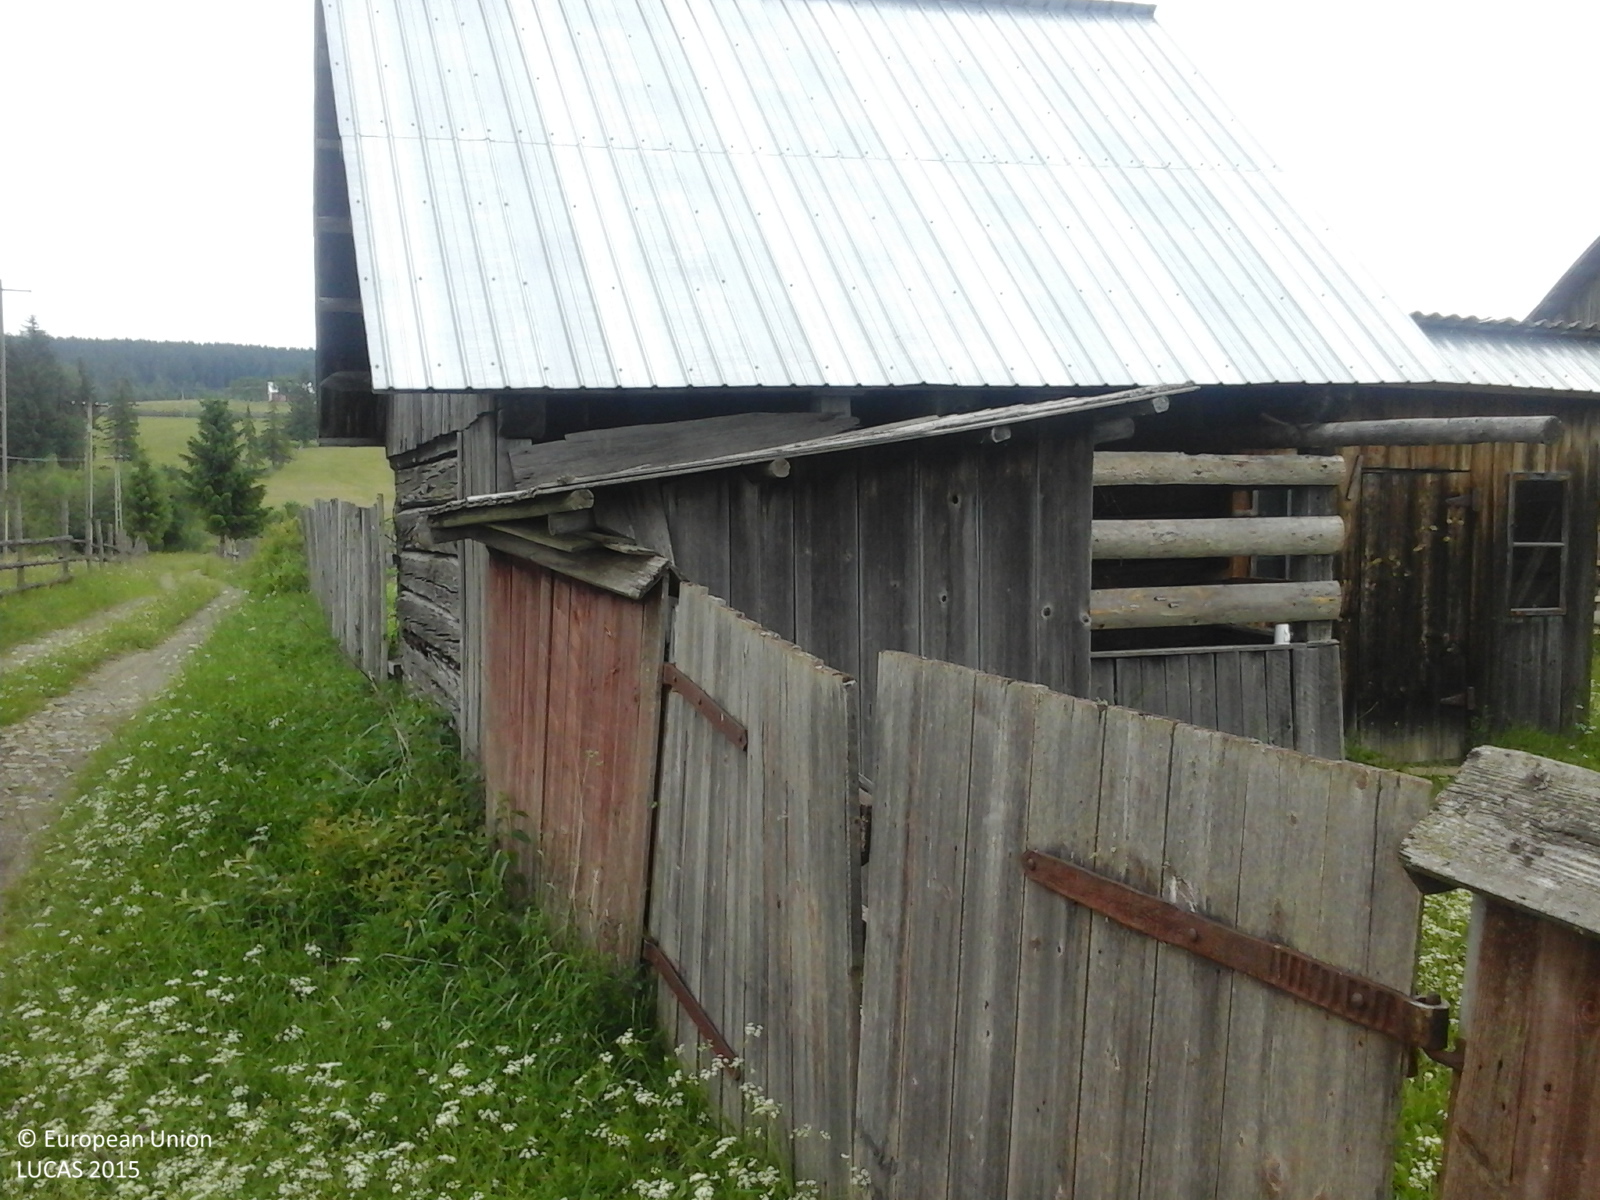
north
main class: Grassland
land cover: Grassland without tree/shrub cover
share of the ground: > 75 %
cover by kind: herbaceous plants 100 %
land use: Agriculture (excluding fallow land and kitchen gardens)
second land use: Residential
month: June
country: RO
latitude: 47.3366
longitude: 25.1271
